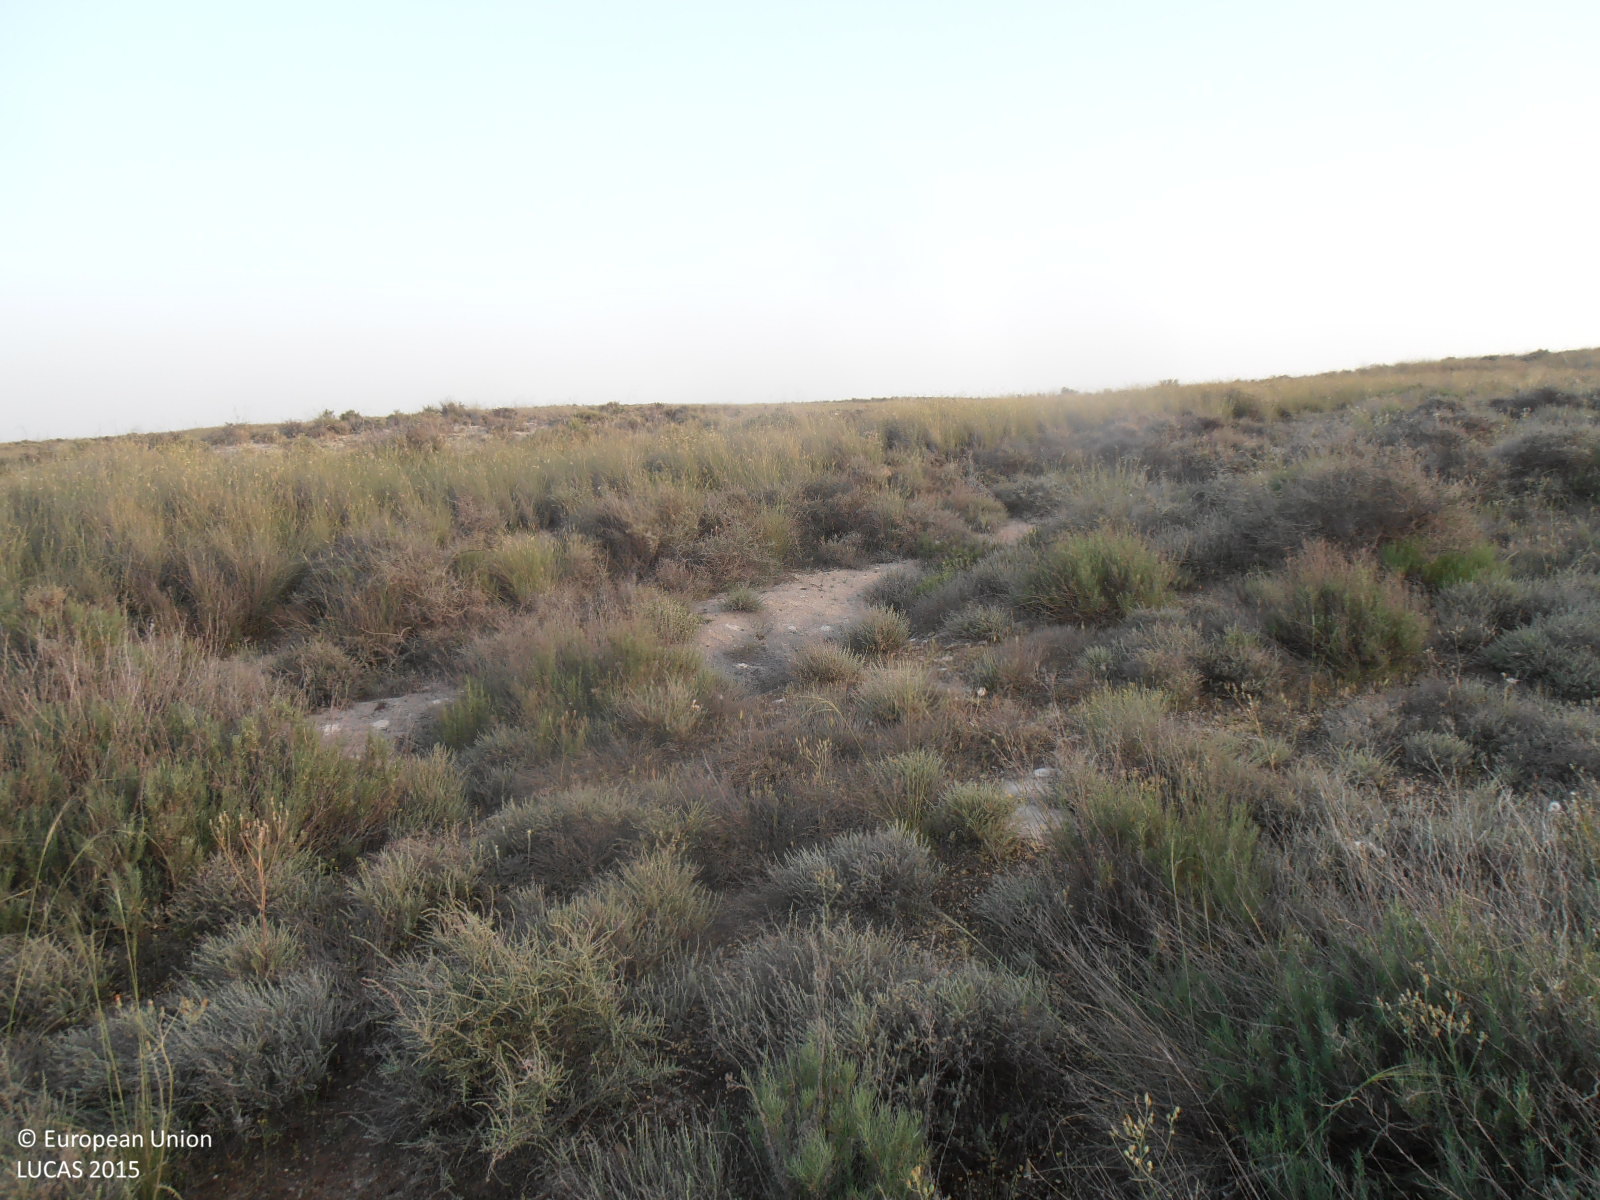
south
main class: Shrubland
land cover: Shrubland without tree cover
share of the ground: > 75 %
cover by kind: shrubs 90 %, herbaceous plants 10 %
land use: Semi-natural and natural areas not in use
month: May
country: ES
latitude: 41.5567
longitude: -1.0409
